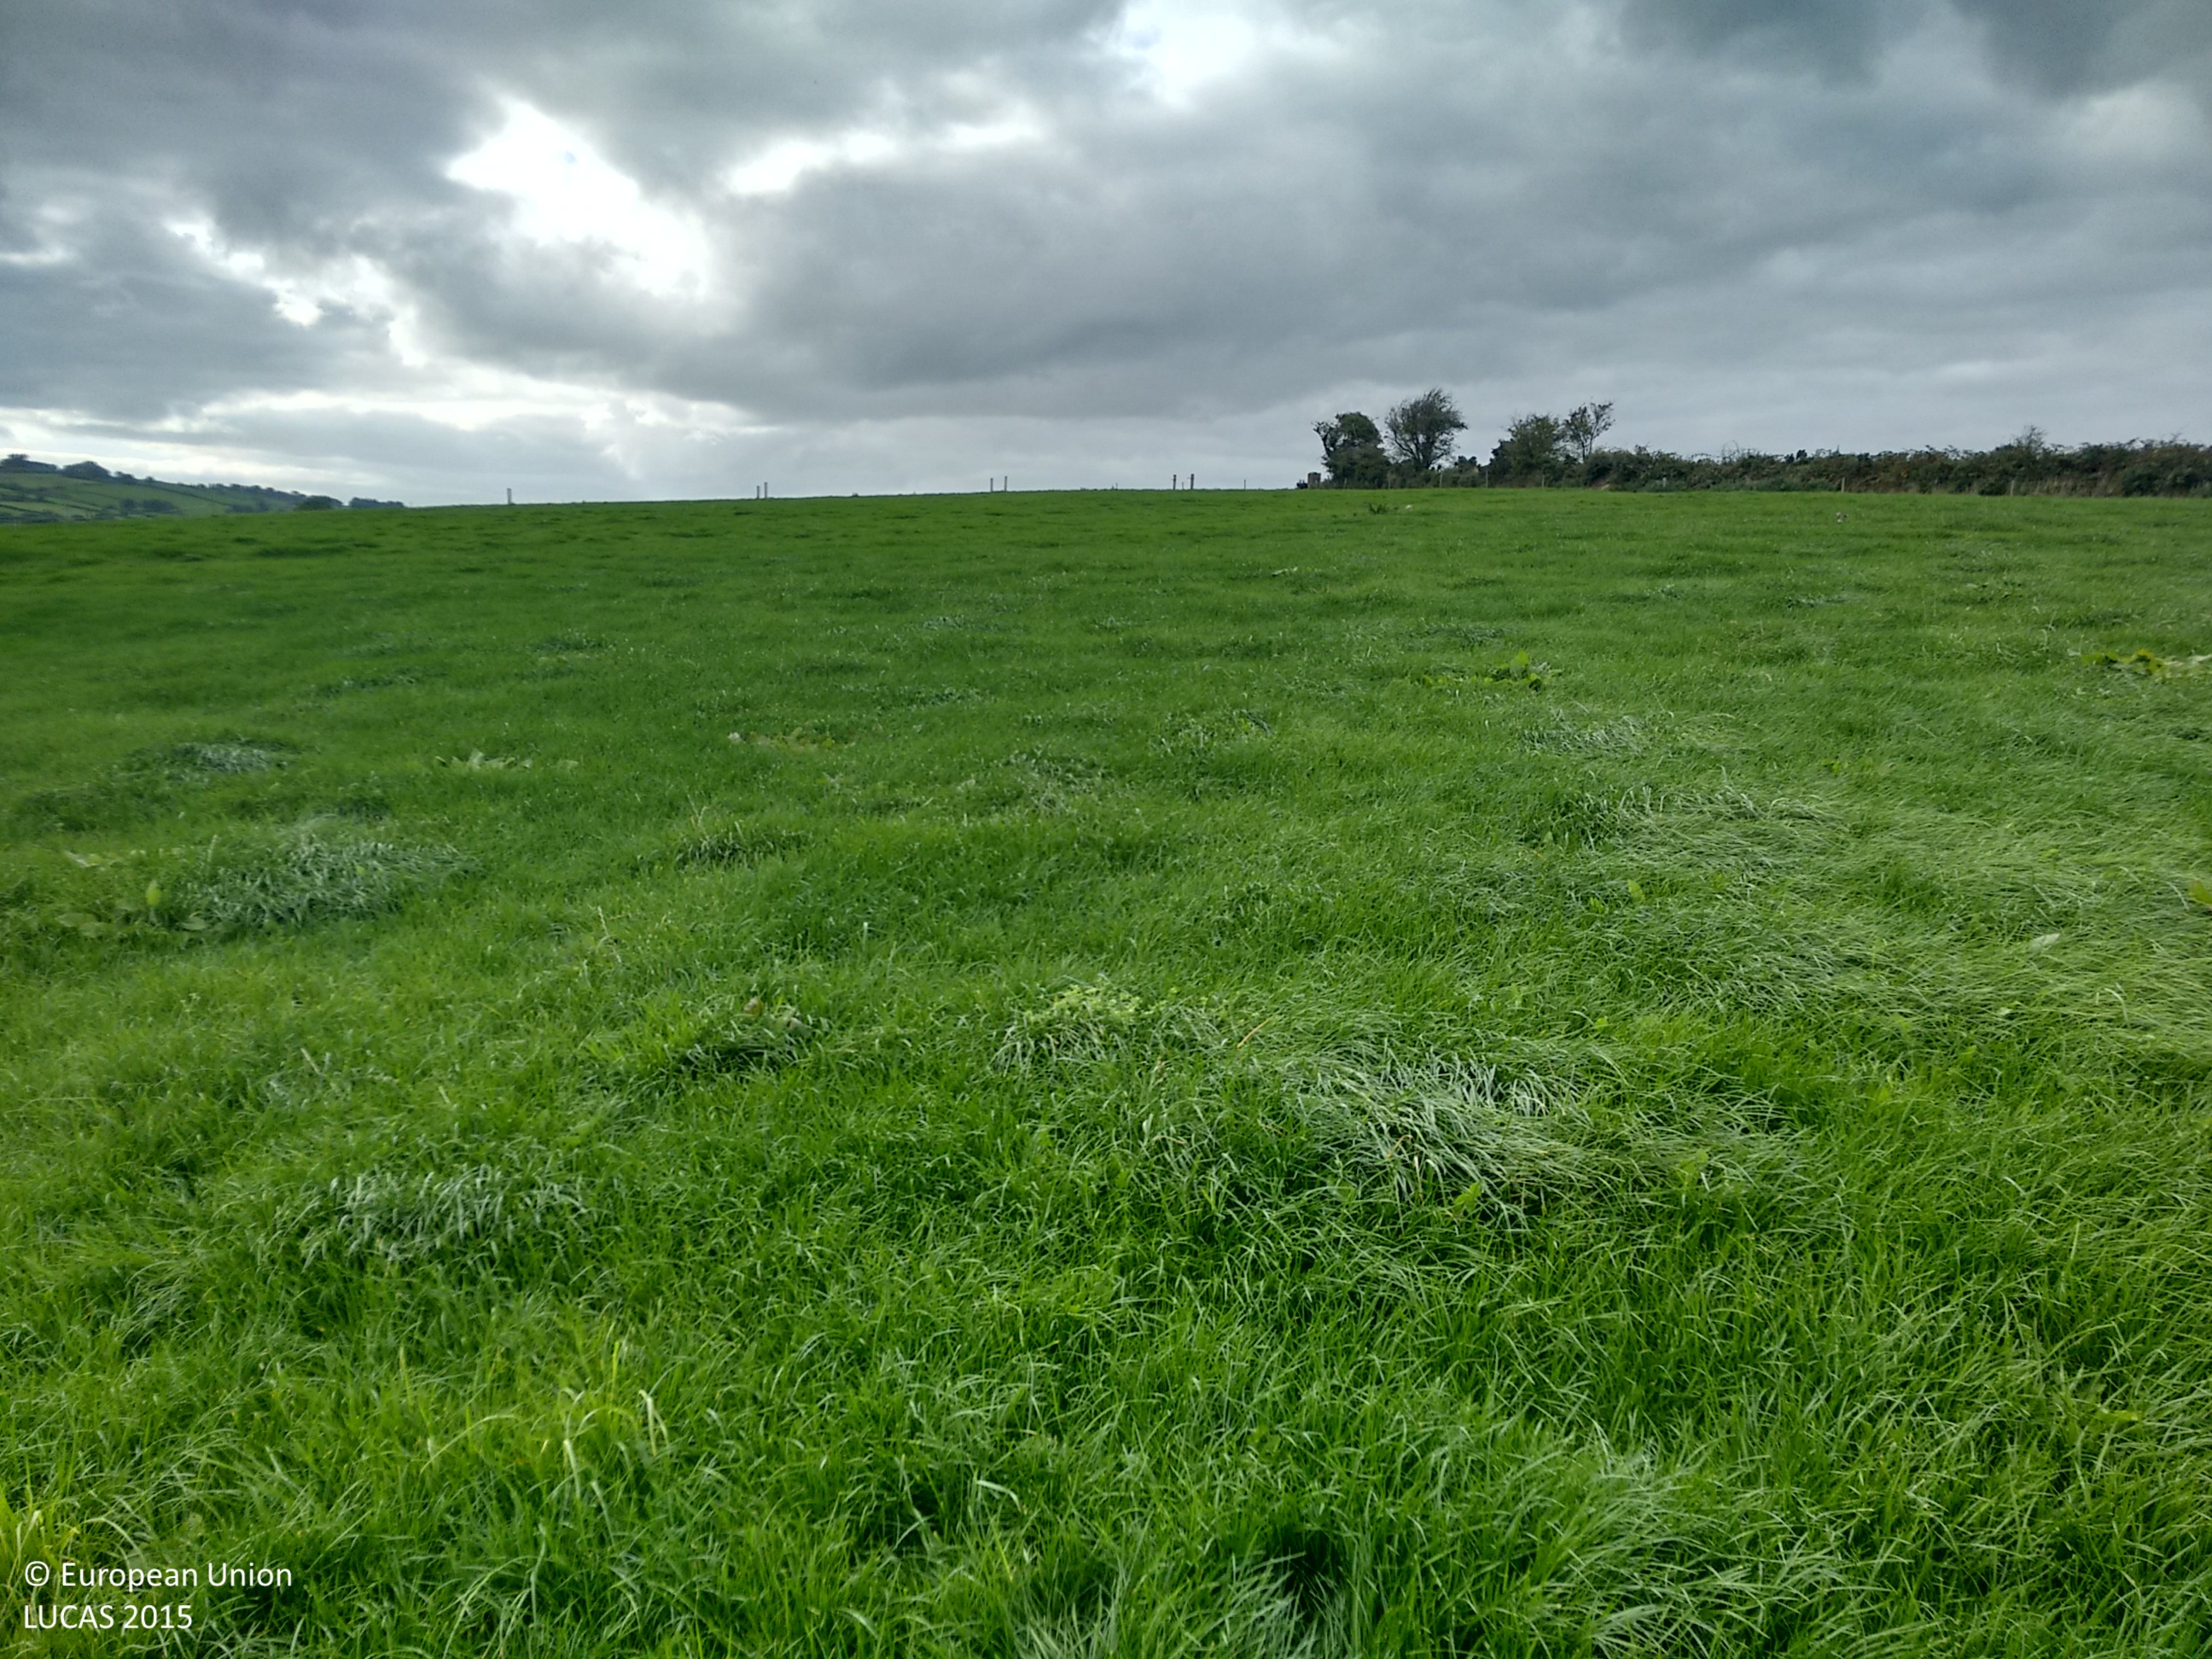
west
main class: Grassland
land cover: Grassland without tree/shrub cover
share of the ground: > 75 %
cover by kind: herbaceous plants 100 %
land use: Agriculture (excluding fallow land and kitchen gardens)
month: September
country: IE
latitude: 52.3332
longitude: -8.9209
